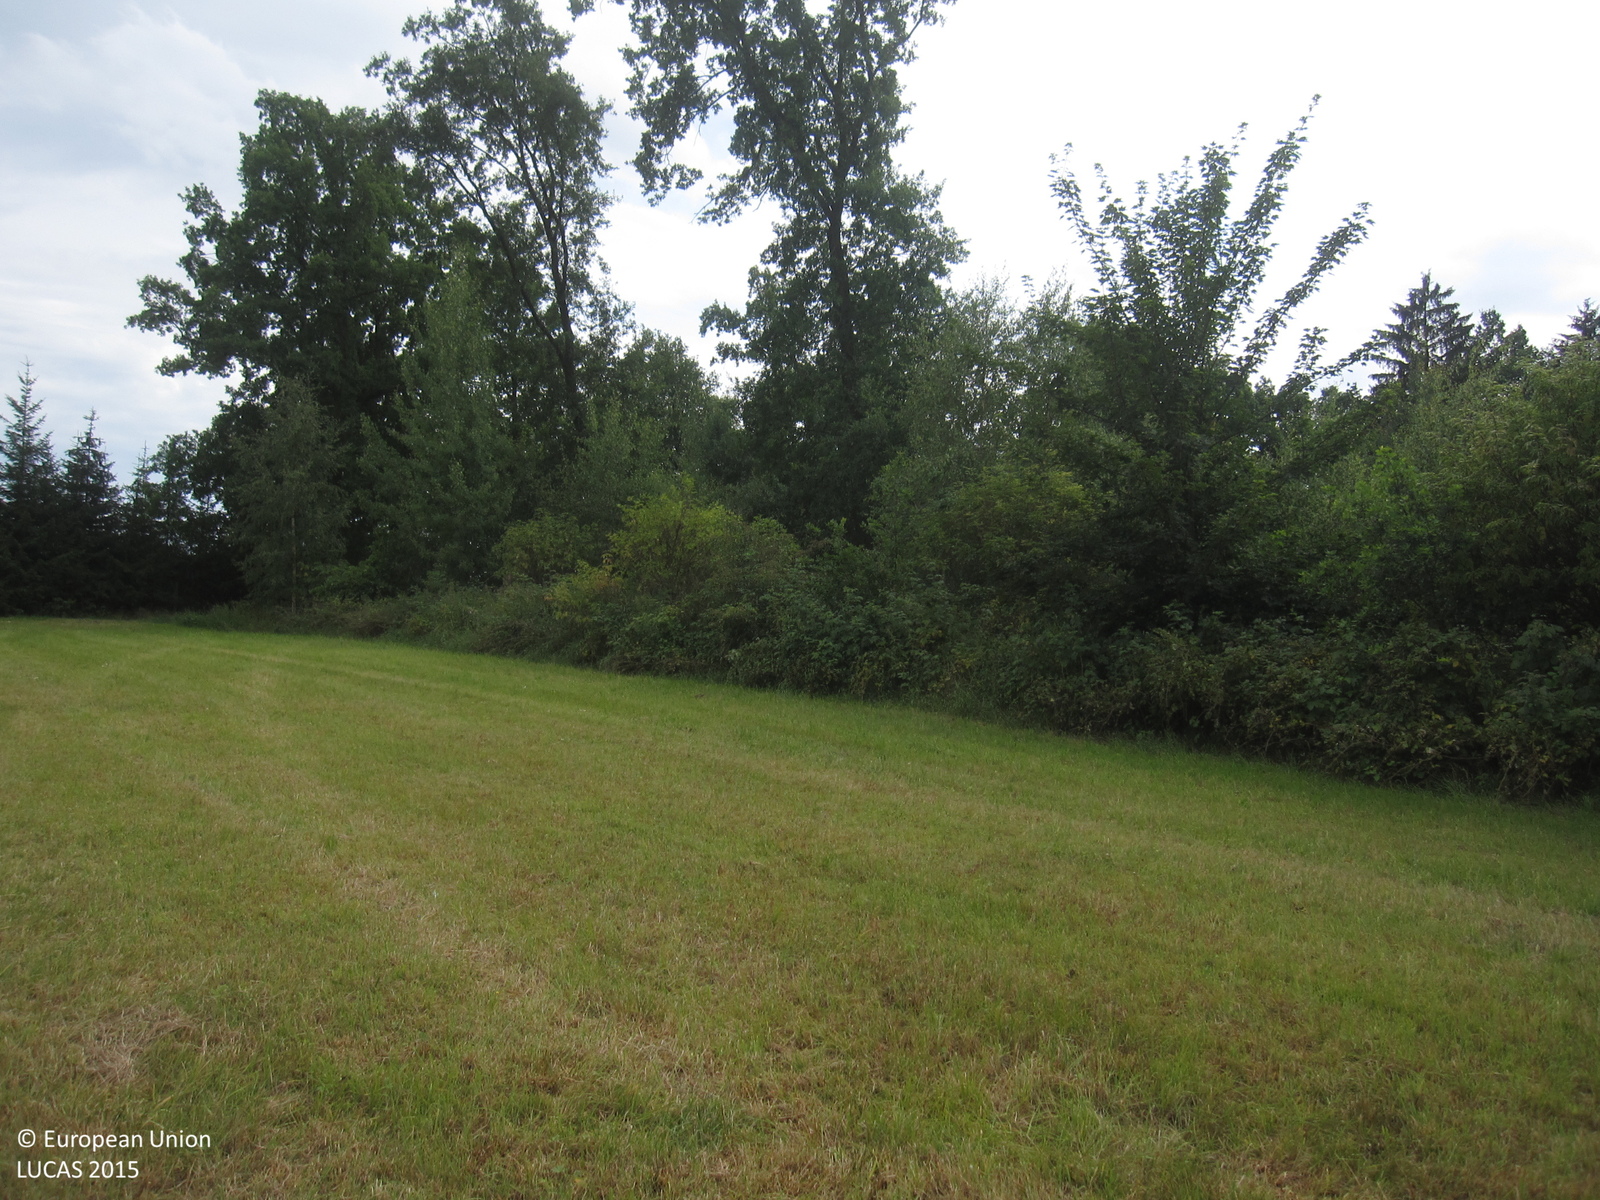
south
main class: Grassland
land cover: Grassland without tree/shrub cover
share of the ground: > 75 %
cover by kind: herbaceous plants 95 %, unconsolidated bare surface 5 %
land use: Agriculture (excluding fallow land and kitchen gardens)
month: August
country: DE
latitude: 50.5426
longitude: 12.1022
